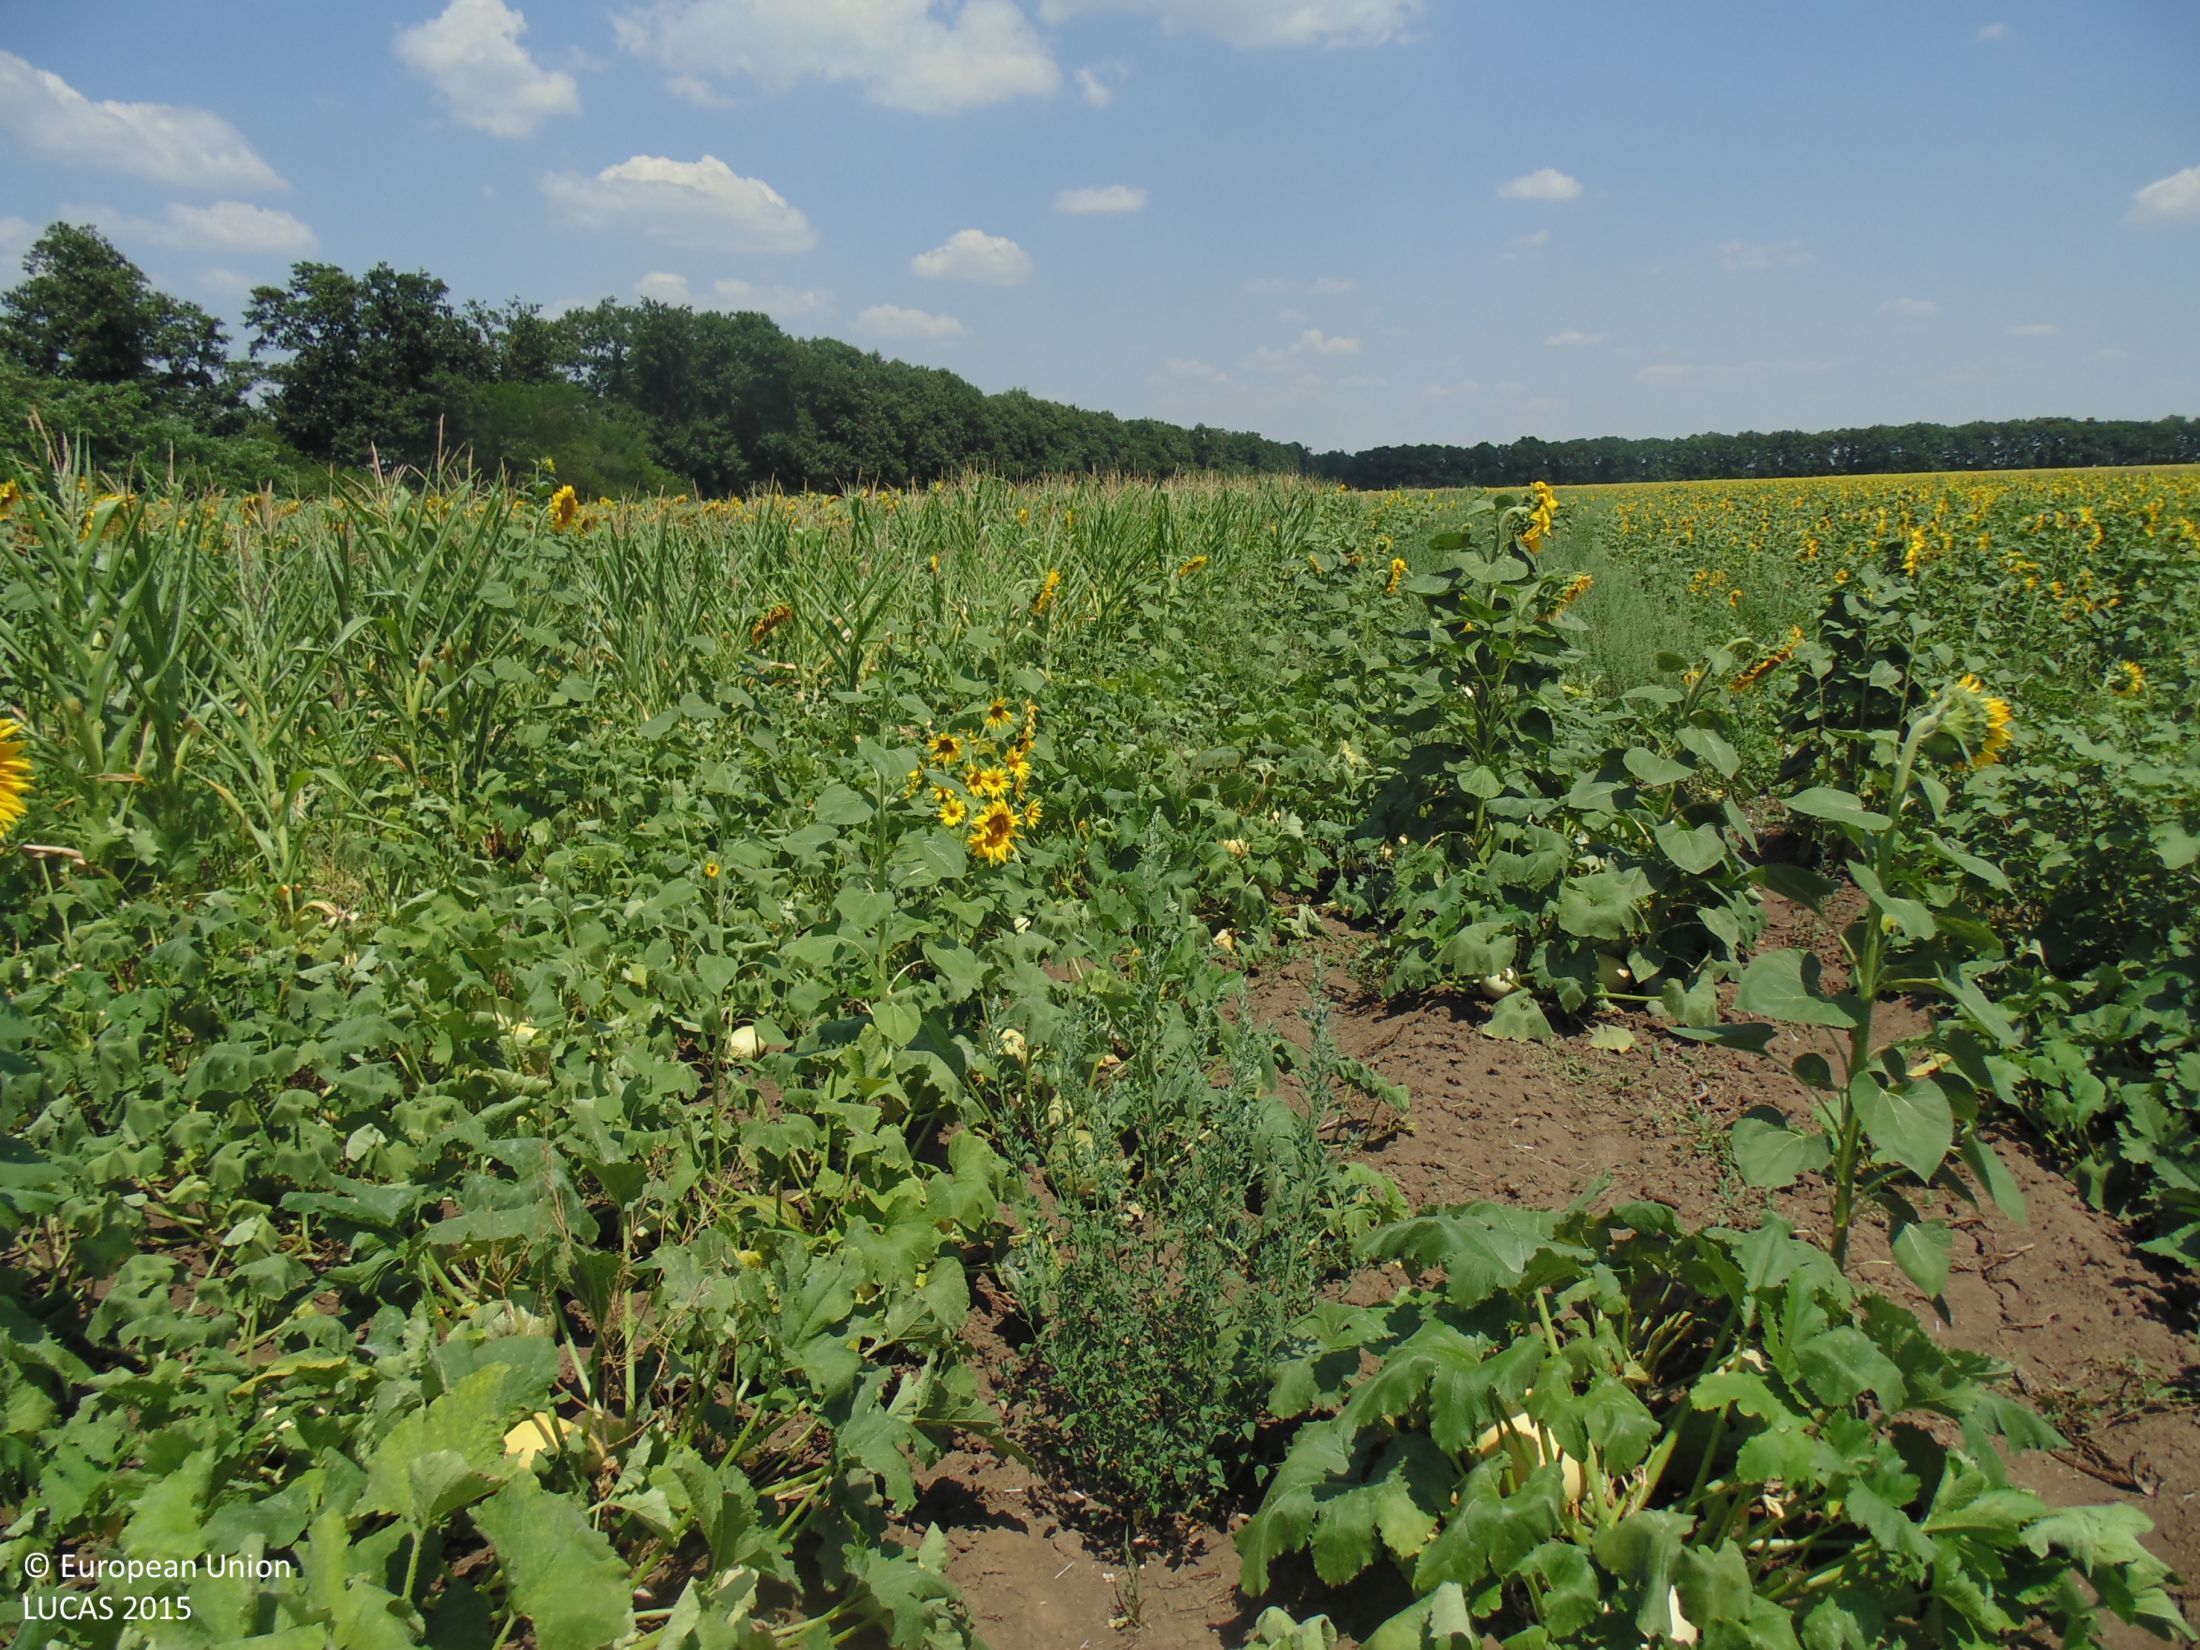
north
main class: Cropland
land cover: Other fresh vegetables
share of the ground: > 75 %
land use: Agriculture (excluding fallow land and kitchen gardens)
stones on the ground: < 10 %
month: July
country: BG
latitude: 43.6294
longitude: 27.6751
